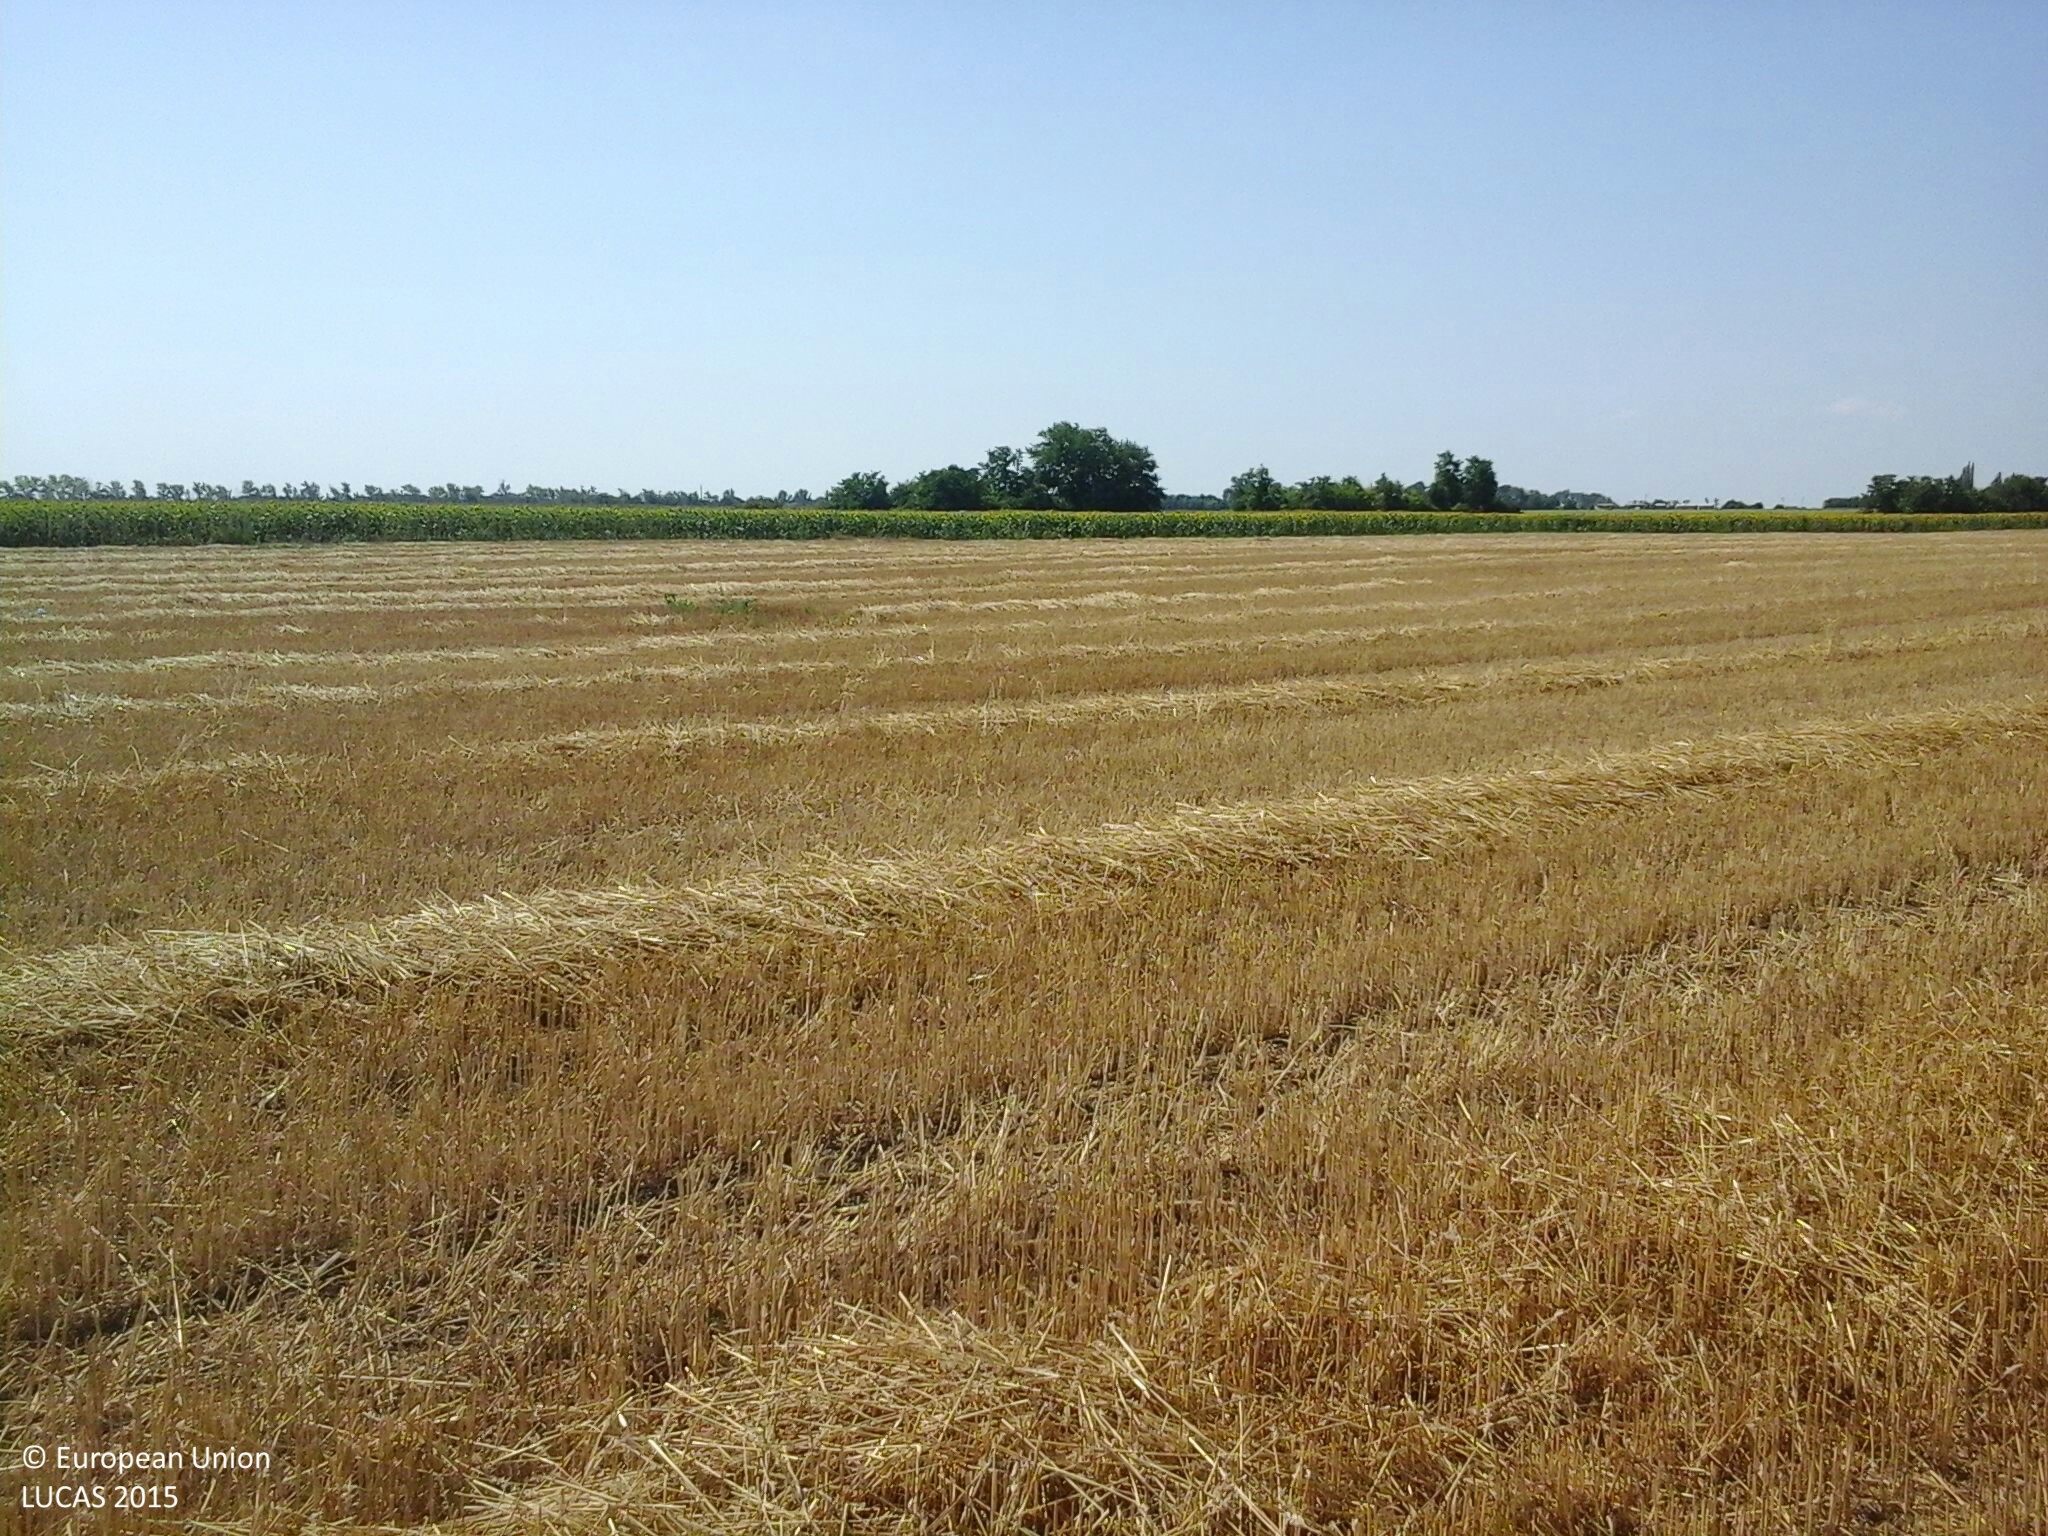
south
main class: Cropland
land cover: Rye
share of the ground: 50 - 75 %
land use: Agriculture (excluding fallow land and kitchen gardens)
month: July
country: HU
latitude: 47.1514
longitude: 18.5193
